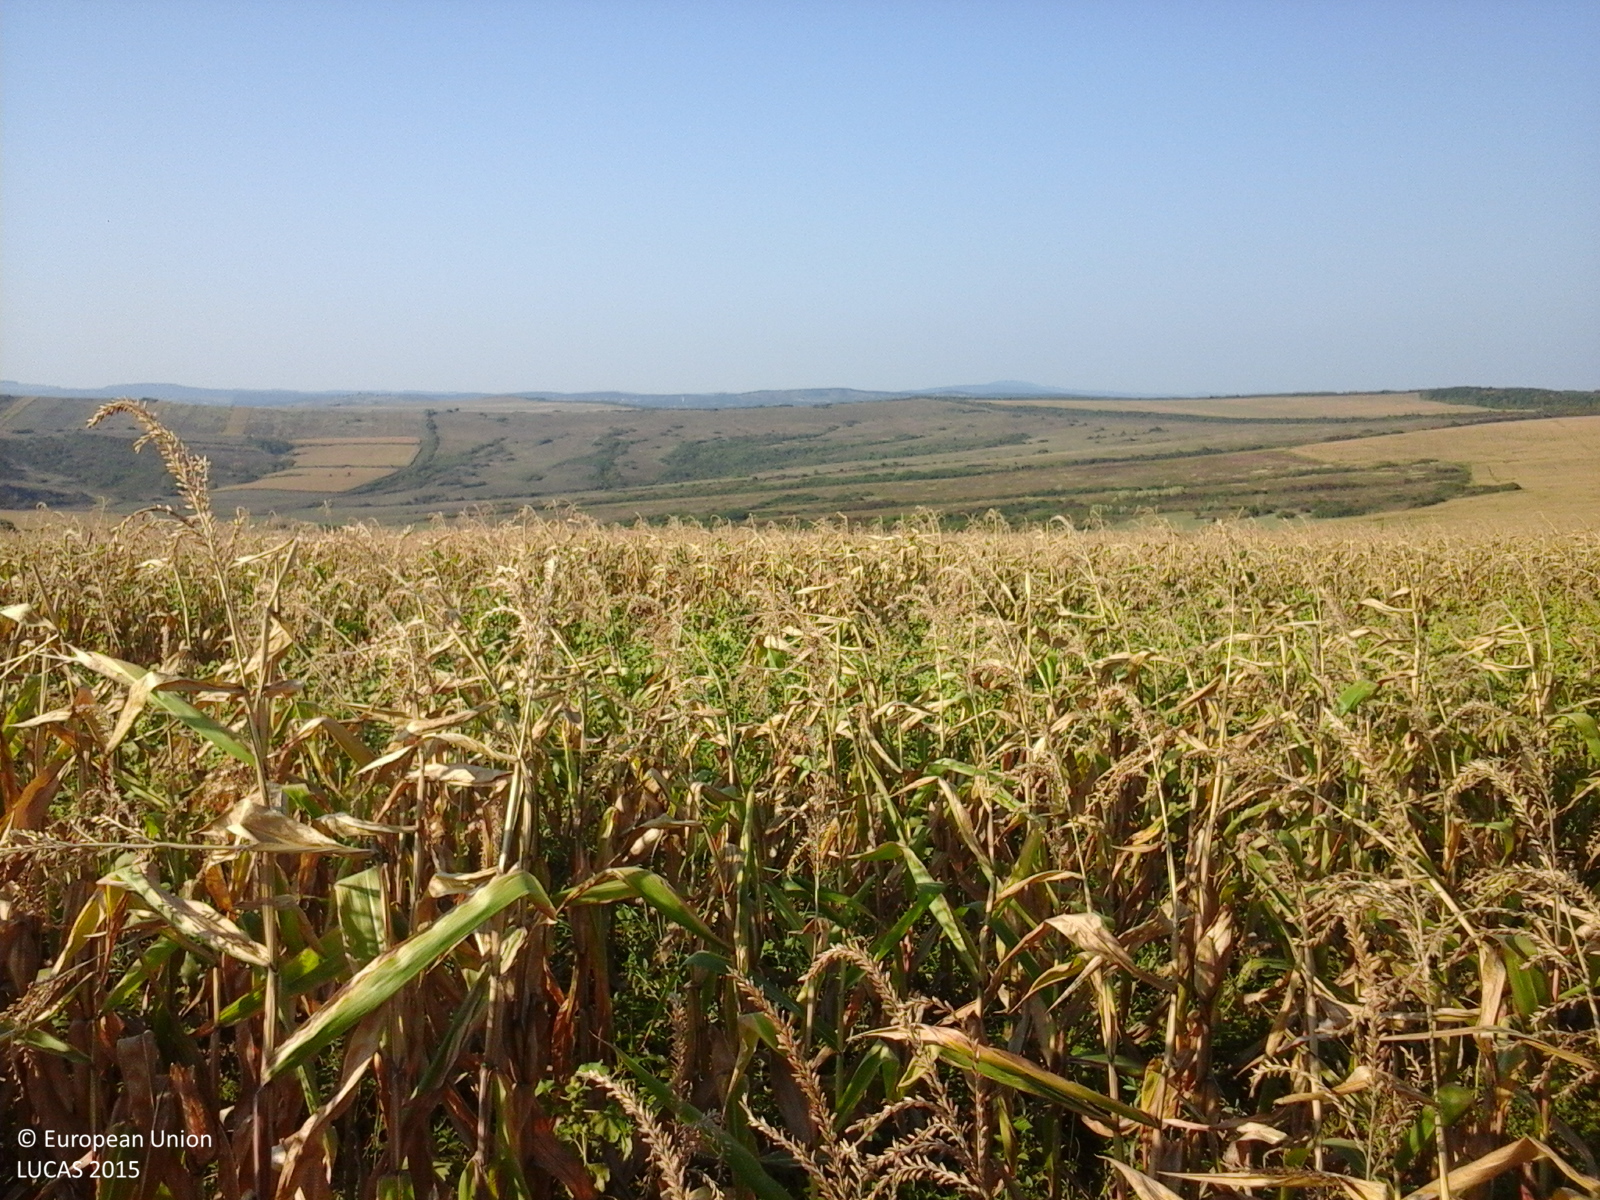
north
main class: Cropland
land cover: Maize
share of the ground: > 75 %
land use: Agriculture (excluding fallow land and kitchen gardens)
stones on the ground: < 10 %
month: September
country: RO
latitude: 47.3347
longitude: 23.0473
